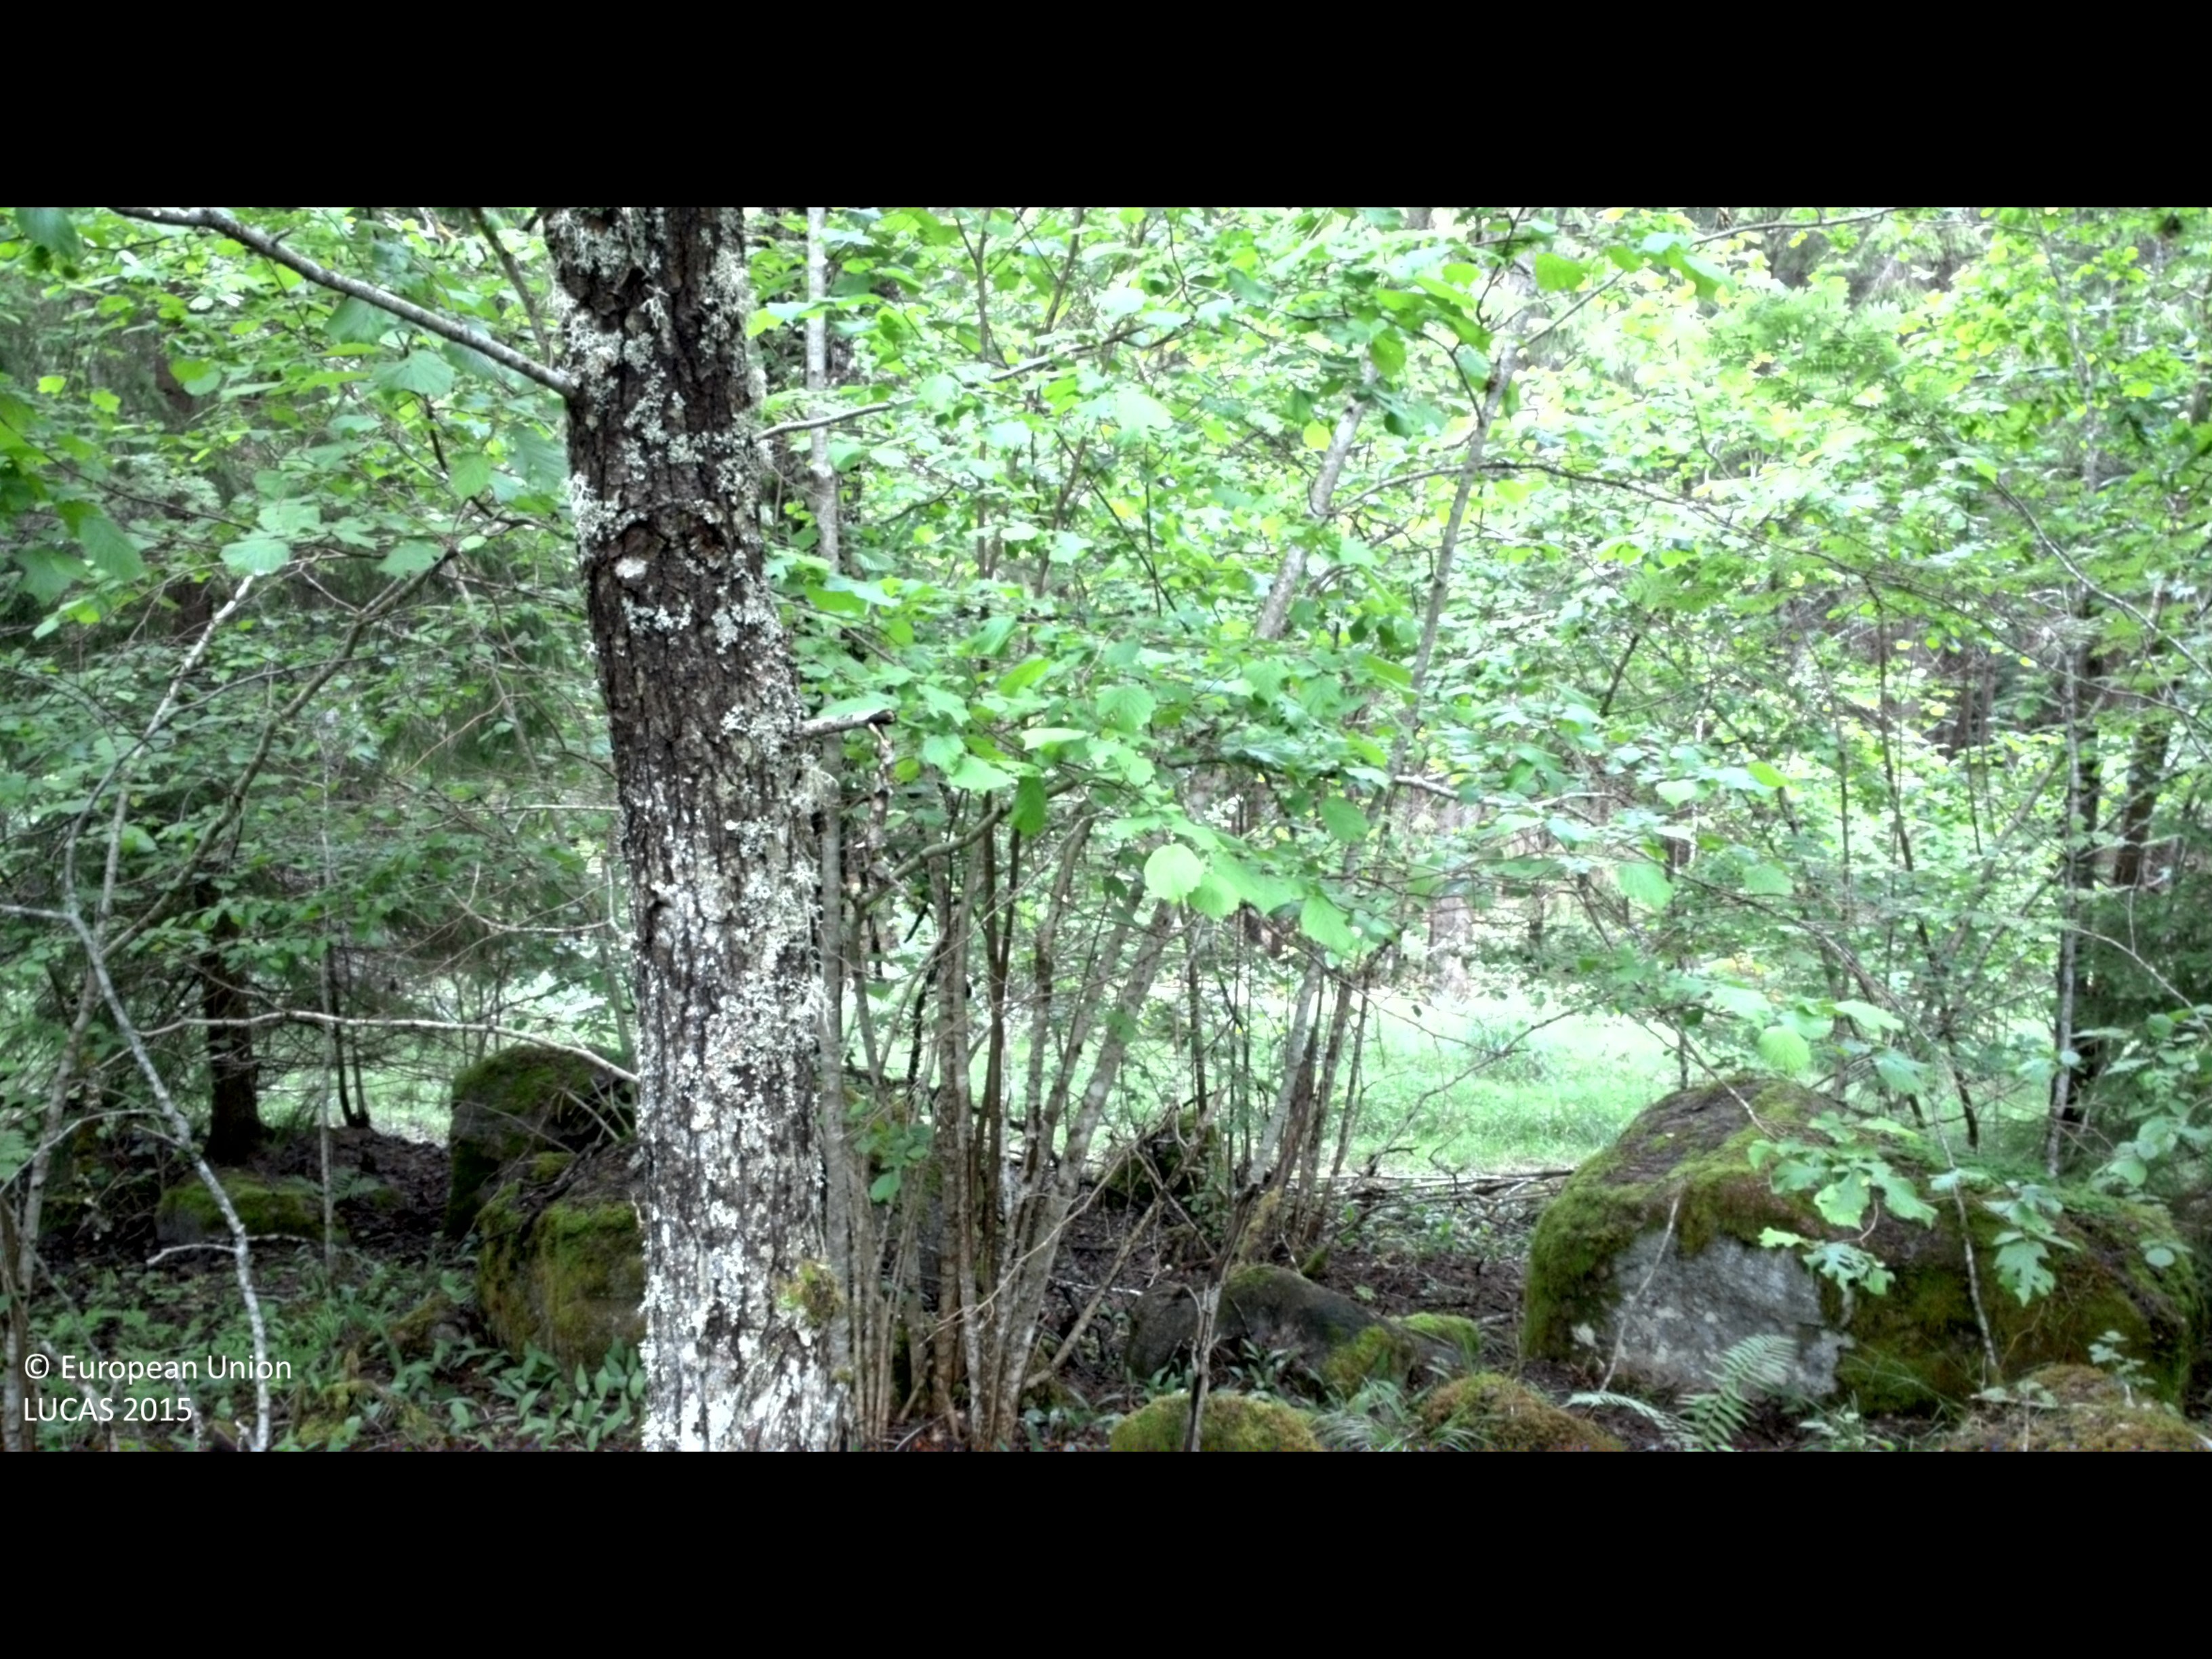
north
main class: Woodland
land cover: Broadleaved woodland
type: boreal forest
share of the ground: 50 - 75 %
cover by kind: broadleaved forest trees 60 %, coniferous forest trees 15 %, shrubs 15 %, herbaceous plants 5 %, lichens and mosses 5 %
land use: Forestry
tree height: > 5 m
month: June
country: SE
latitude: 58.0265
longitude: 16.1090
